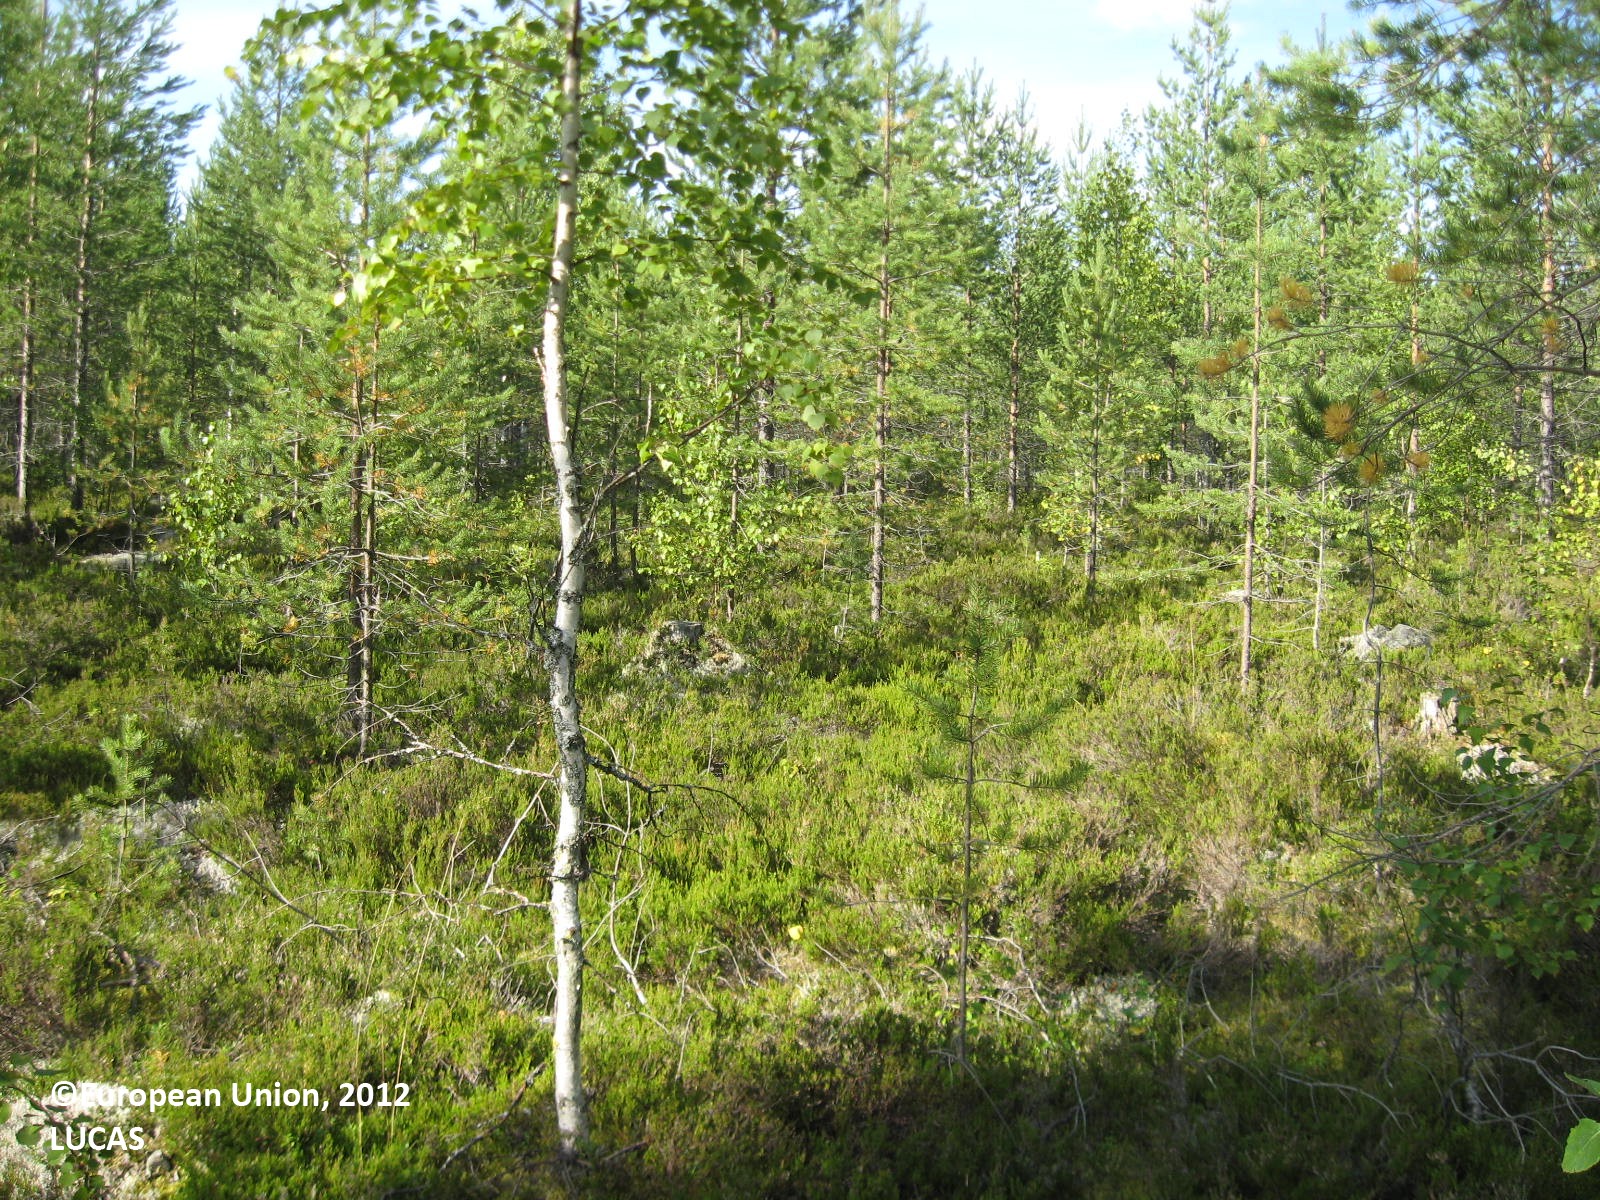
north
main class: Woodland
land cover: Pine dominated mixed woodland
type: boreal forest
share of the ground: > 75 %
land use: Forestry
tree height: > 5 m
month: August
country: FI
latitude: 63.6382
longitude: 29.6287
